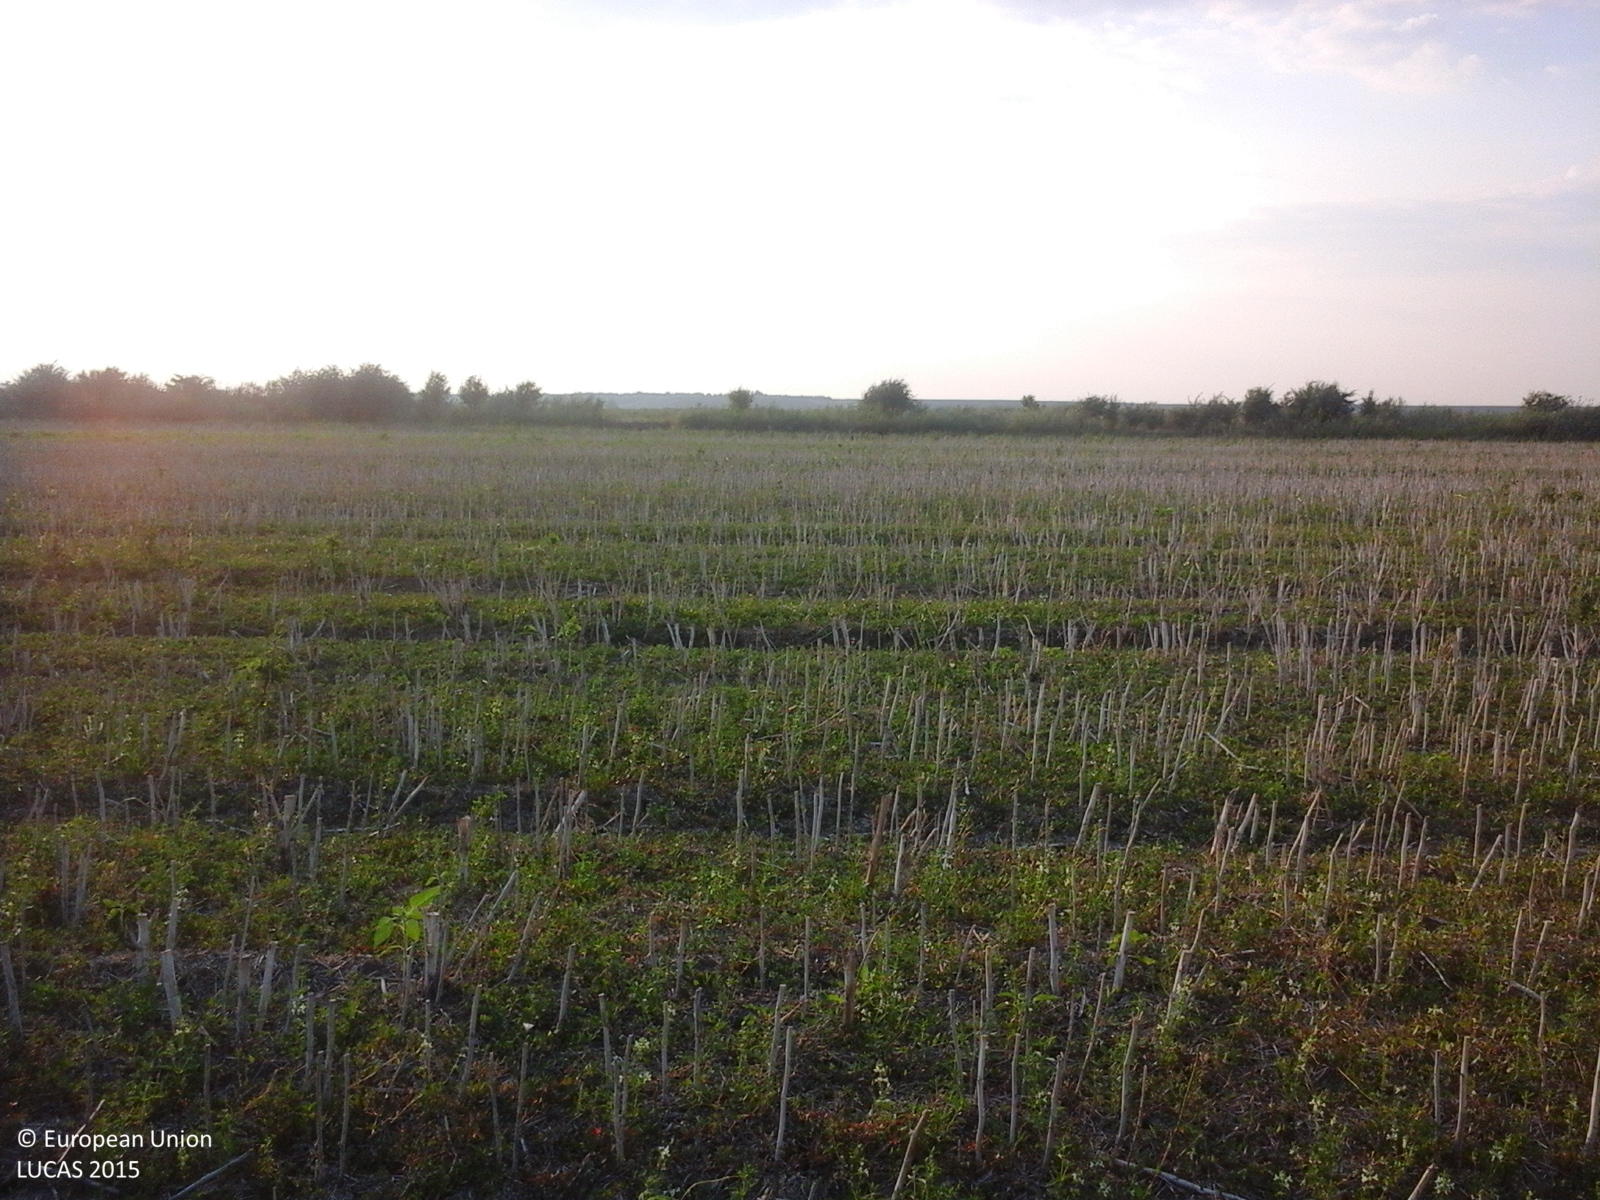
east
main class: Cropland
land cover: Rape and turnip rape
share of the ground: 10 - 25 %
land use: Agriculture (excluding fallow land and kitchen gardens)
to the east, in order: Rape and turnip rape; Abandoned hedges; Ditches and canals; Abandoned hedges; Grass margins; Tracks; Grass margins; Rape and turnip rape
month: July
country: RO
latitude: 44.5497
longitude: 27.1392
